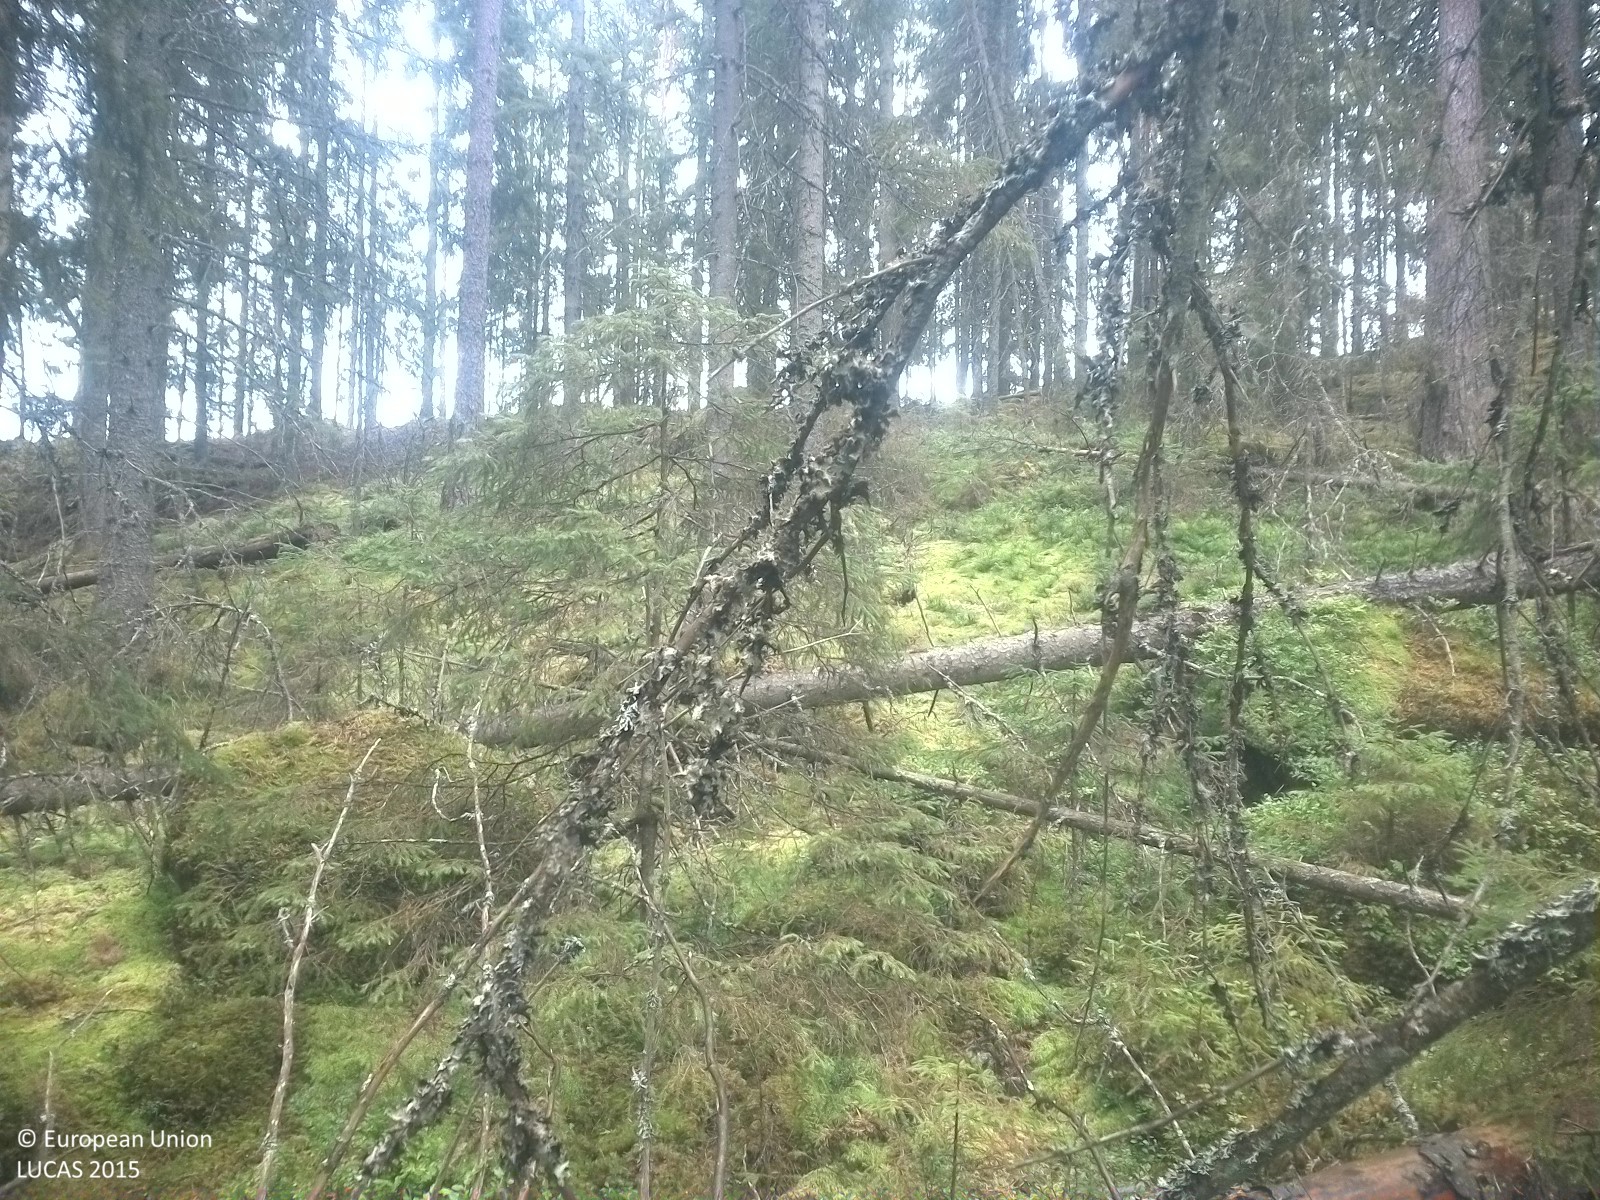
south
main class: Woodland
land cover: Spruce dominated coniferous woodland
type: boreal forest
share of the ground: 25 - 50 %
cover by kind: coniferous forest trees 40 %, herbaceous plants 35 %, lichens and mosses 25 %
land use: Forestry
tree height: > 5 m
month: August
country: SE
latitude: 58.9145
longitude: 15.6017
